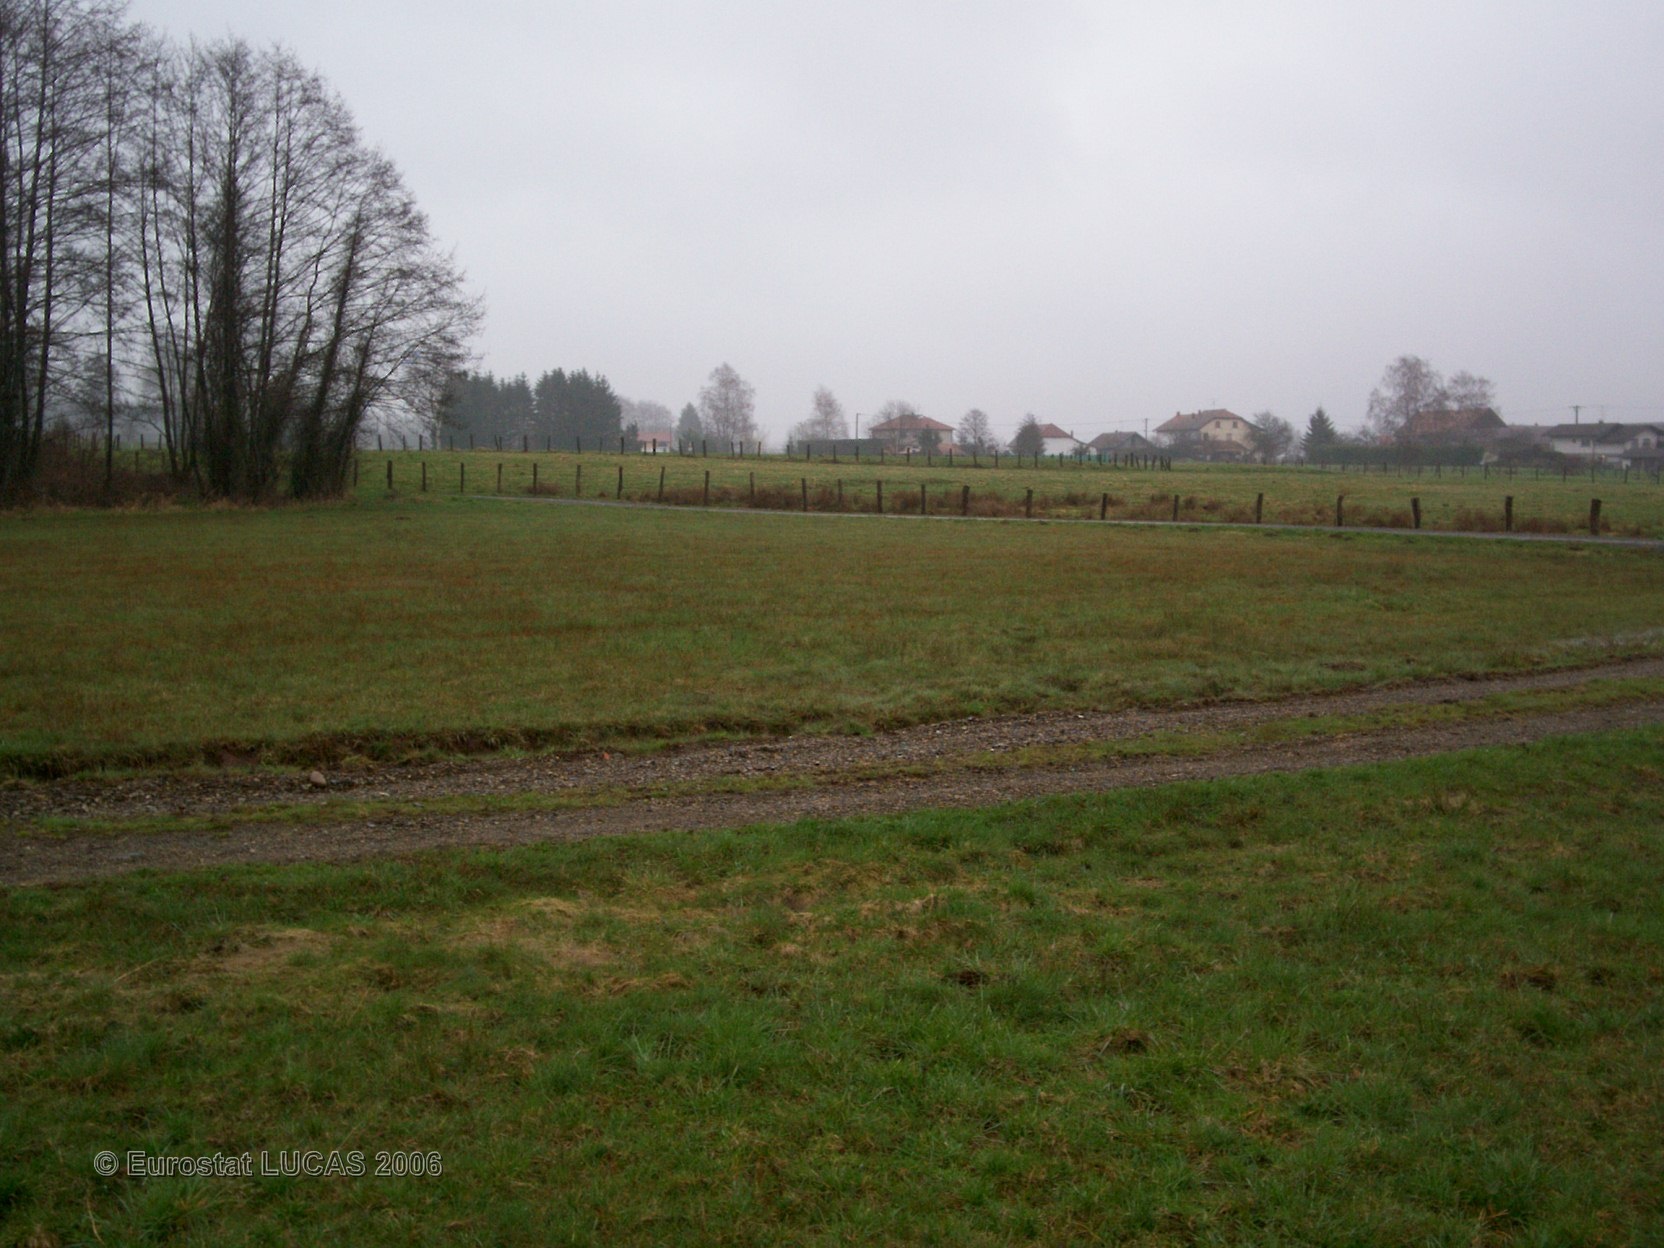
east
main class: Grassland
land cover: Grassland without tree/shrub cover
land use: Agriculture (excluding fallow land and kitchen gardens)
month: April
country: FR
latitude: 47.7093
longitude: 6.8160
